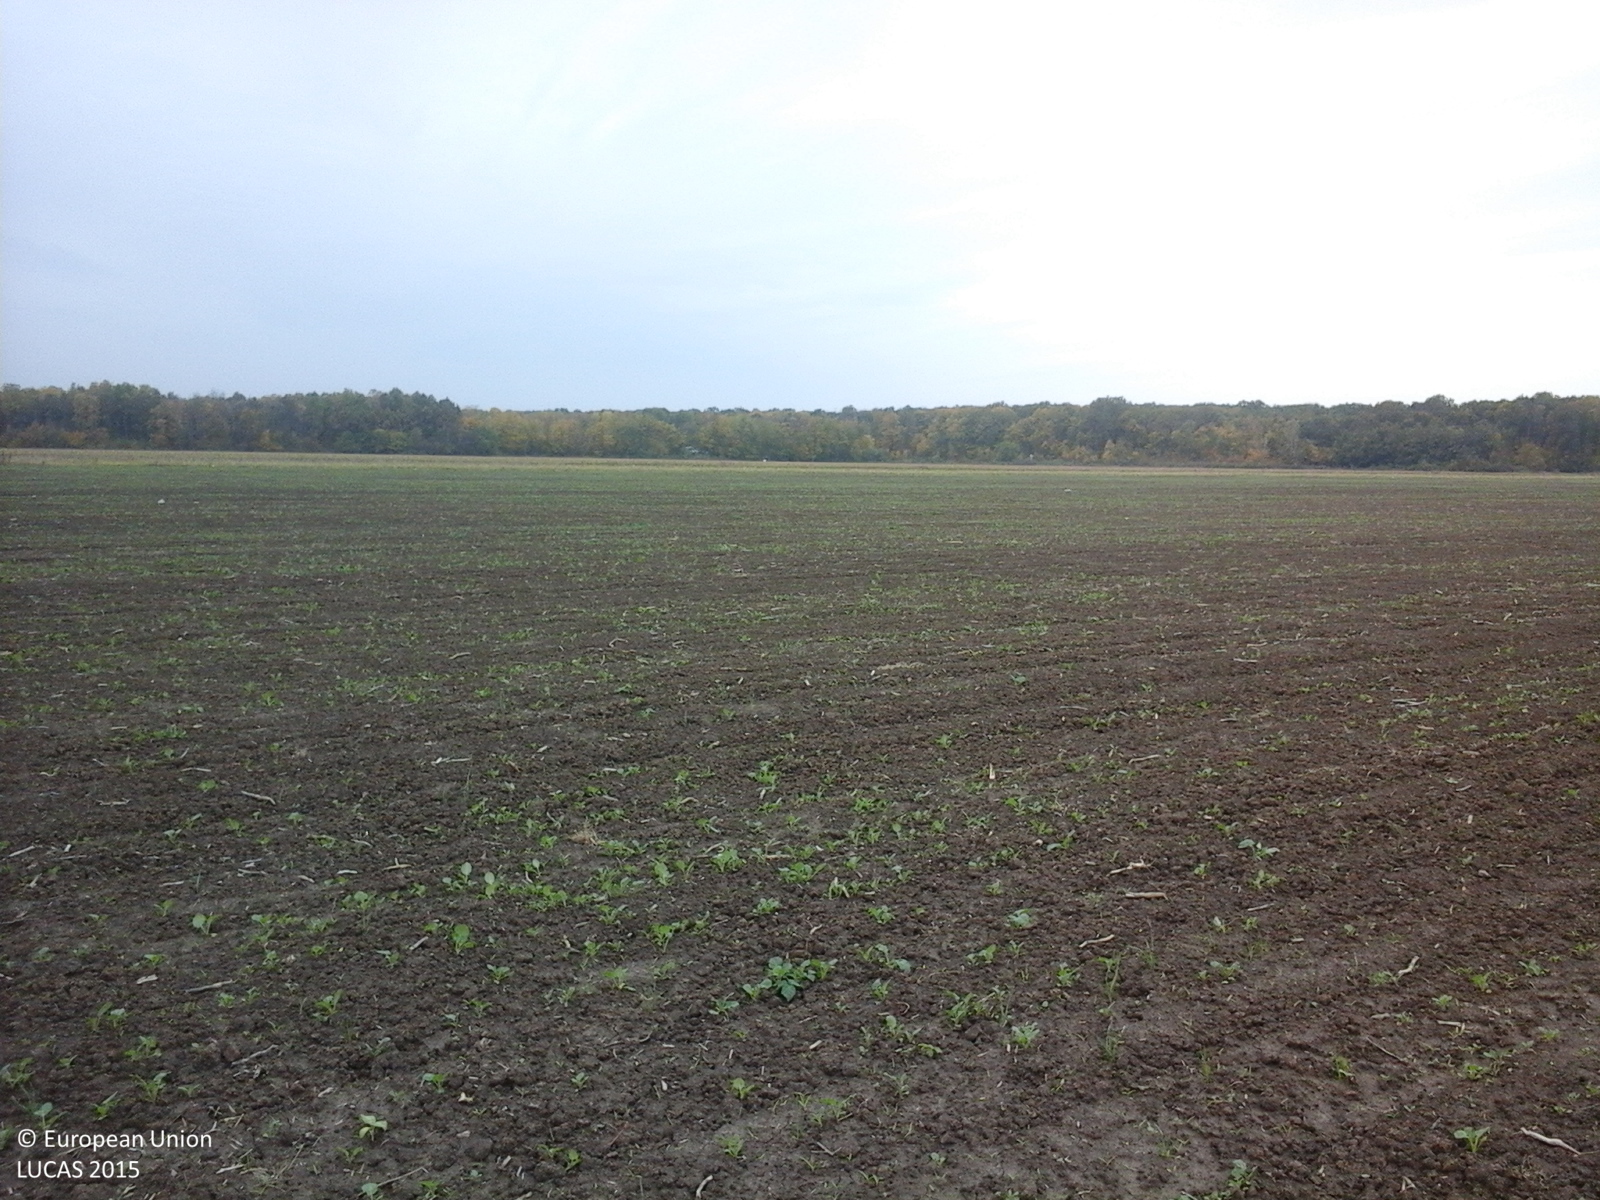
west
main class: Cropland
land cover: Rape and turnip rape
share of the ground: < 10 %
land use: Agriculture (excluding fallow land and kitchen gardens)
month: October
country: RO
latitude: 44.8459
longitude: 26.2181
